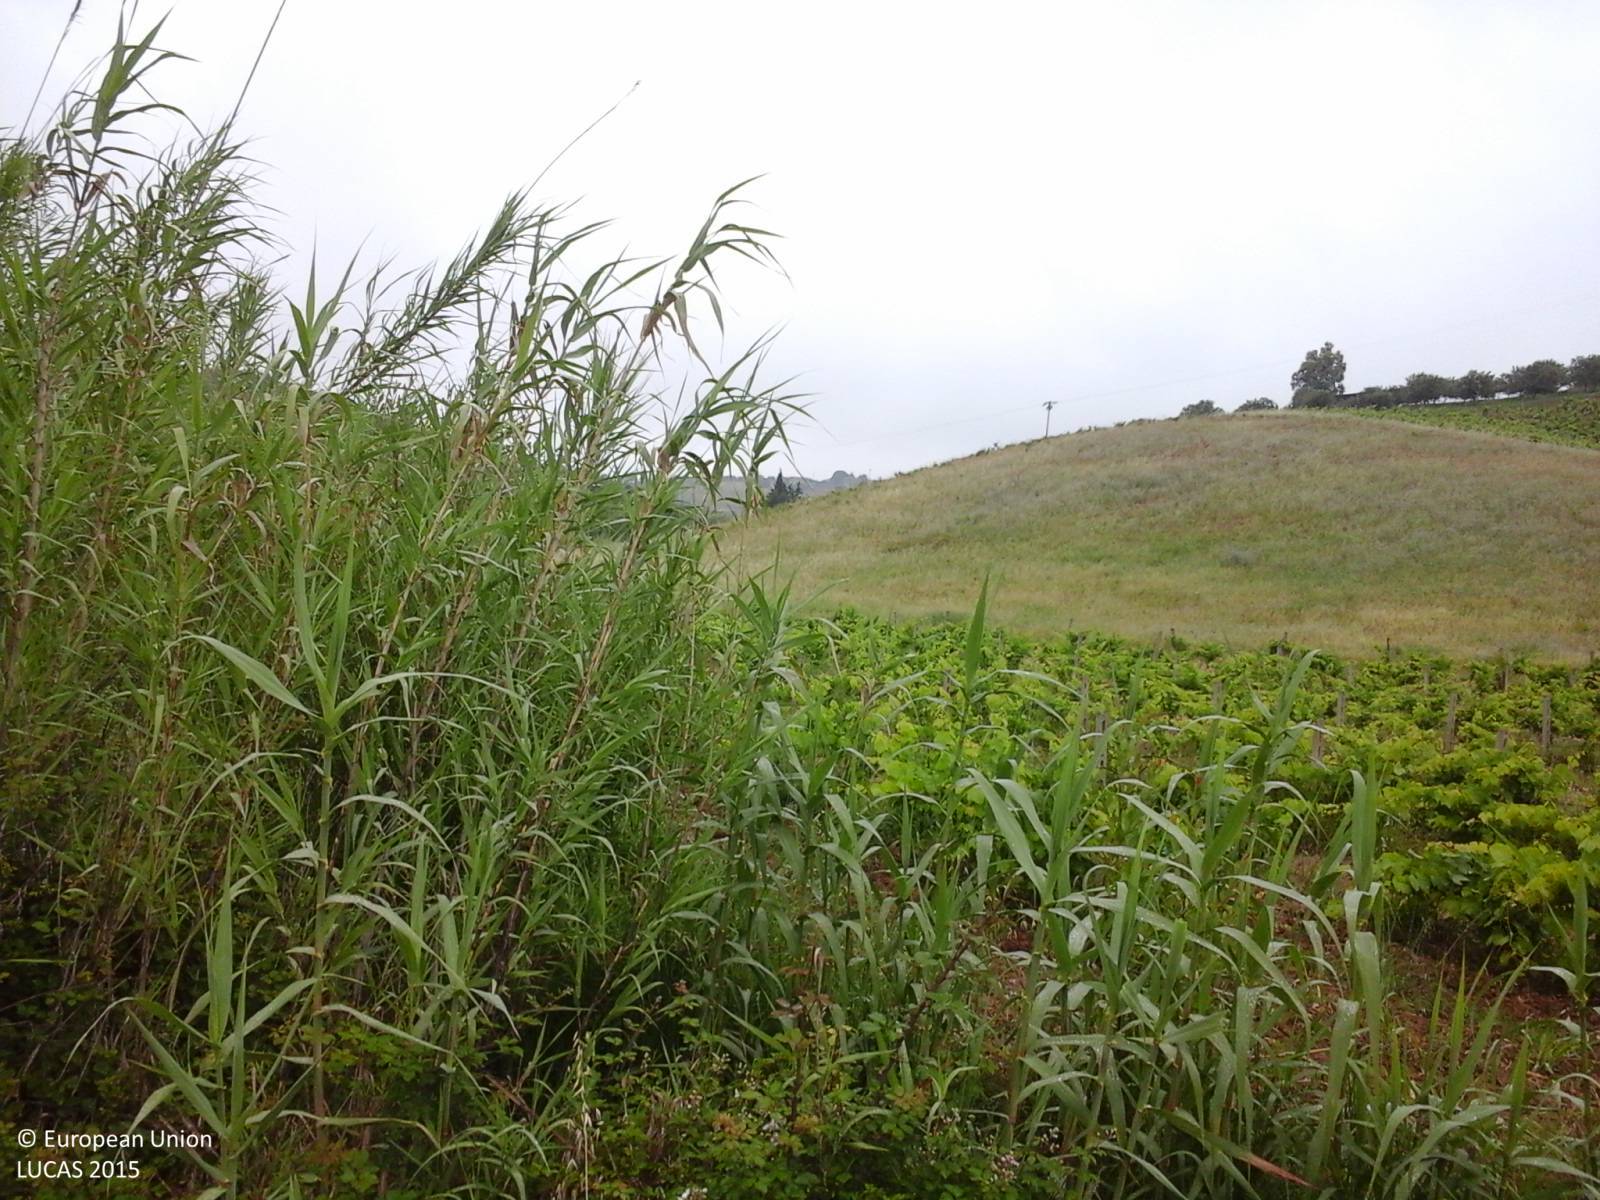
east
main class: Cropland
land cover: Vineyards
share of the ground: > 75 %
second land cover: Other bare soil
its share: > 75 %
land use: Agriculture (excluding fallow land and kitchen gardens)
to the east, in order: Vineyards; Other bare soil; Grass margins; Olive groves; Fences; Olive groves; Other citrus fruit; Fences; Olive groves
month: May
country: IT
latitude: 37.9496
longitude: 13.1524
